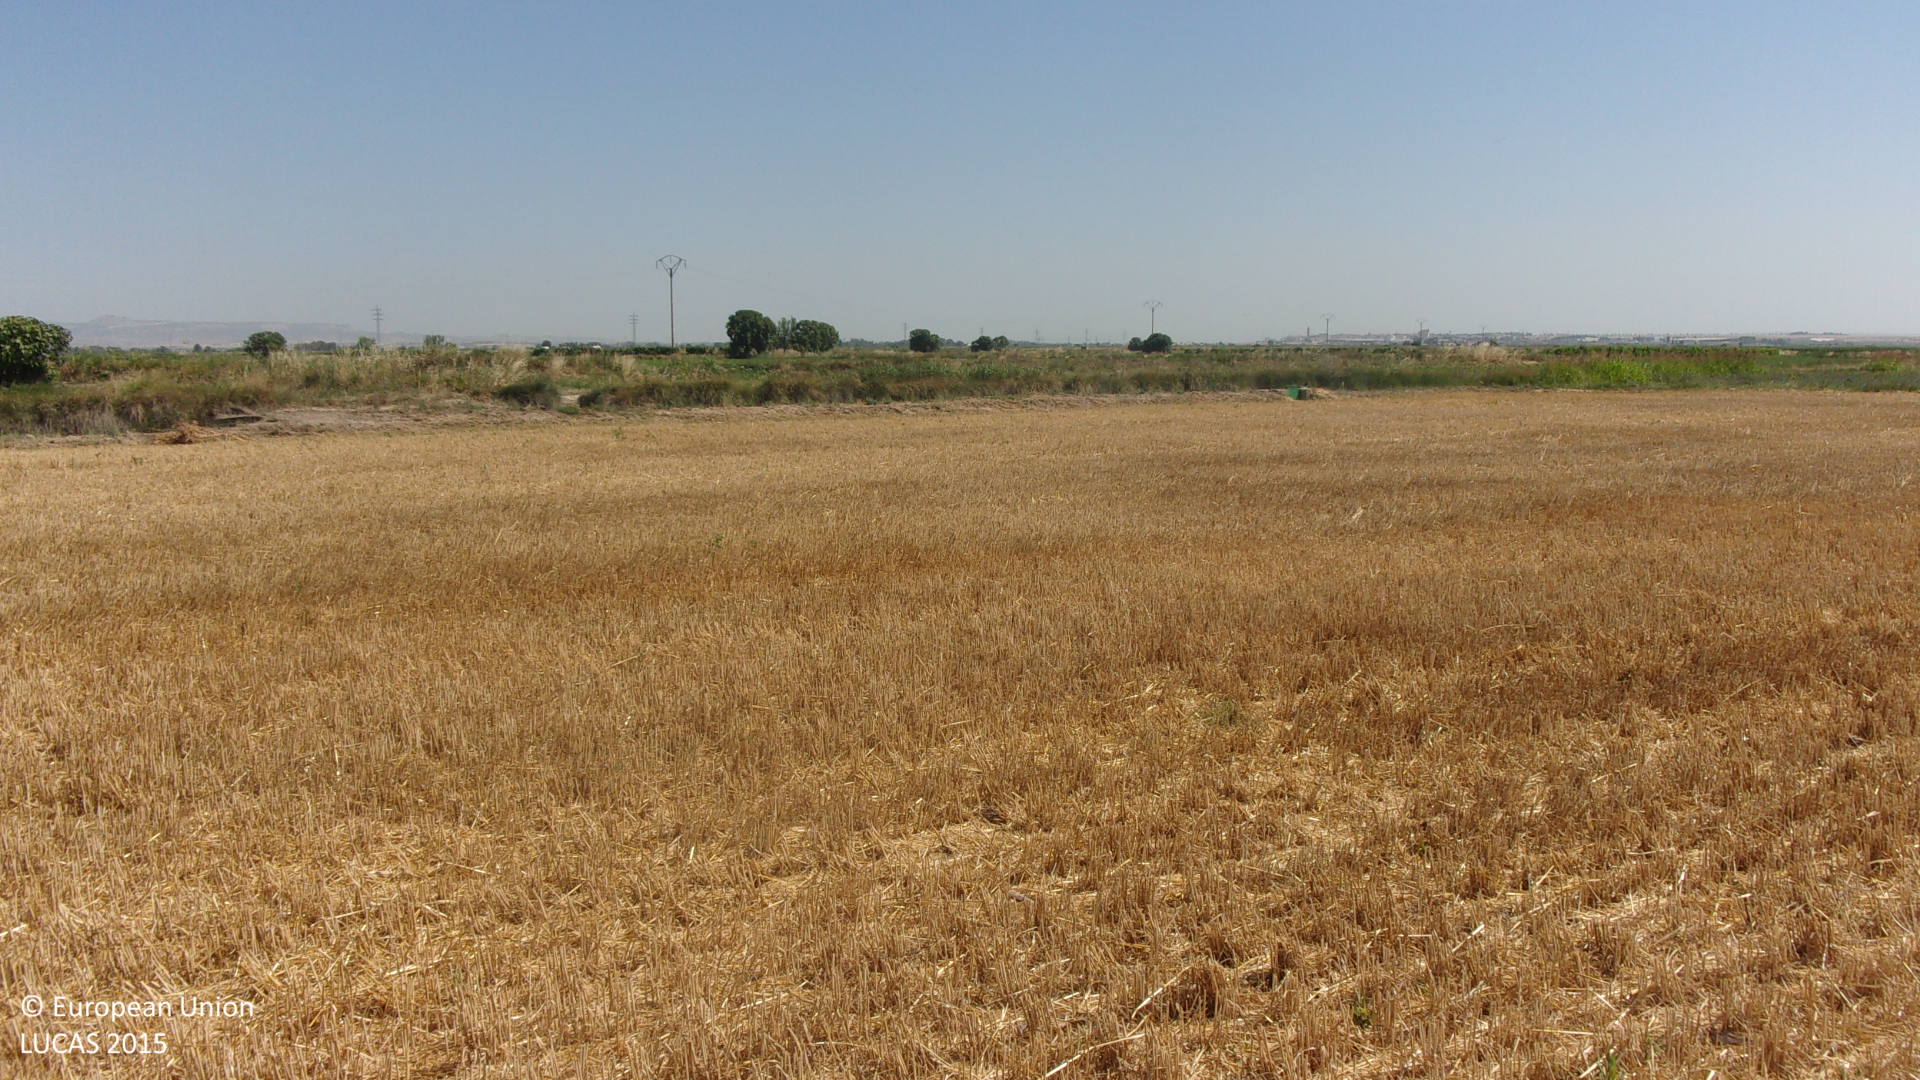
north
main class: Cropland
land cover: Durum wheat
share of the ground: < 10 %
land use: Agriculture (excluding fallow land and kitchen gardens)
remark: Harvested field
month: July
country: ES
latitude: 41.8746
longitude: -1.2932
